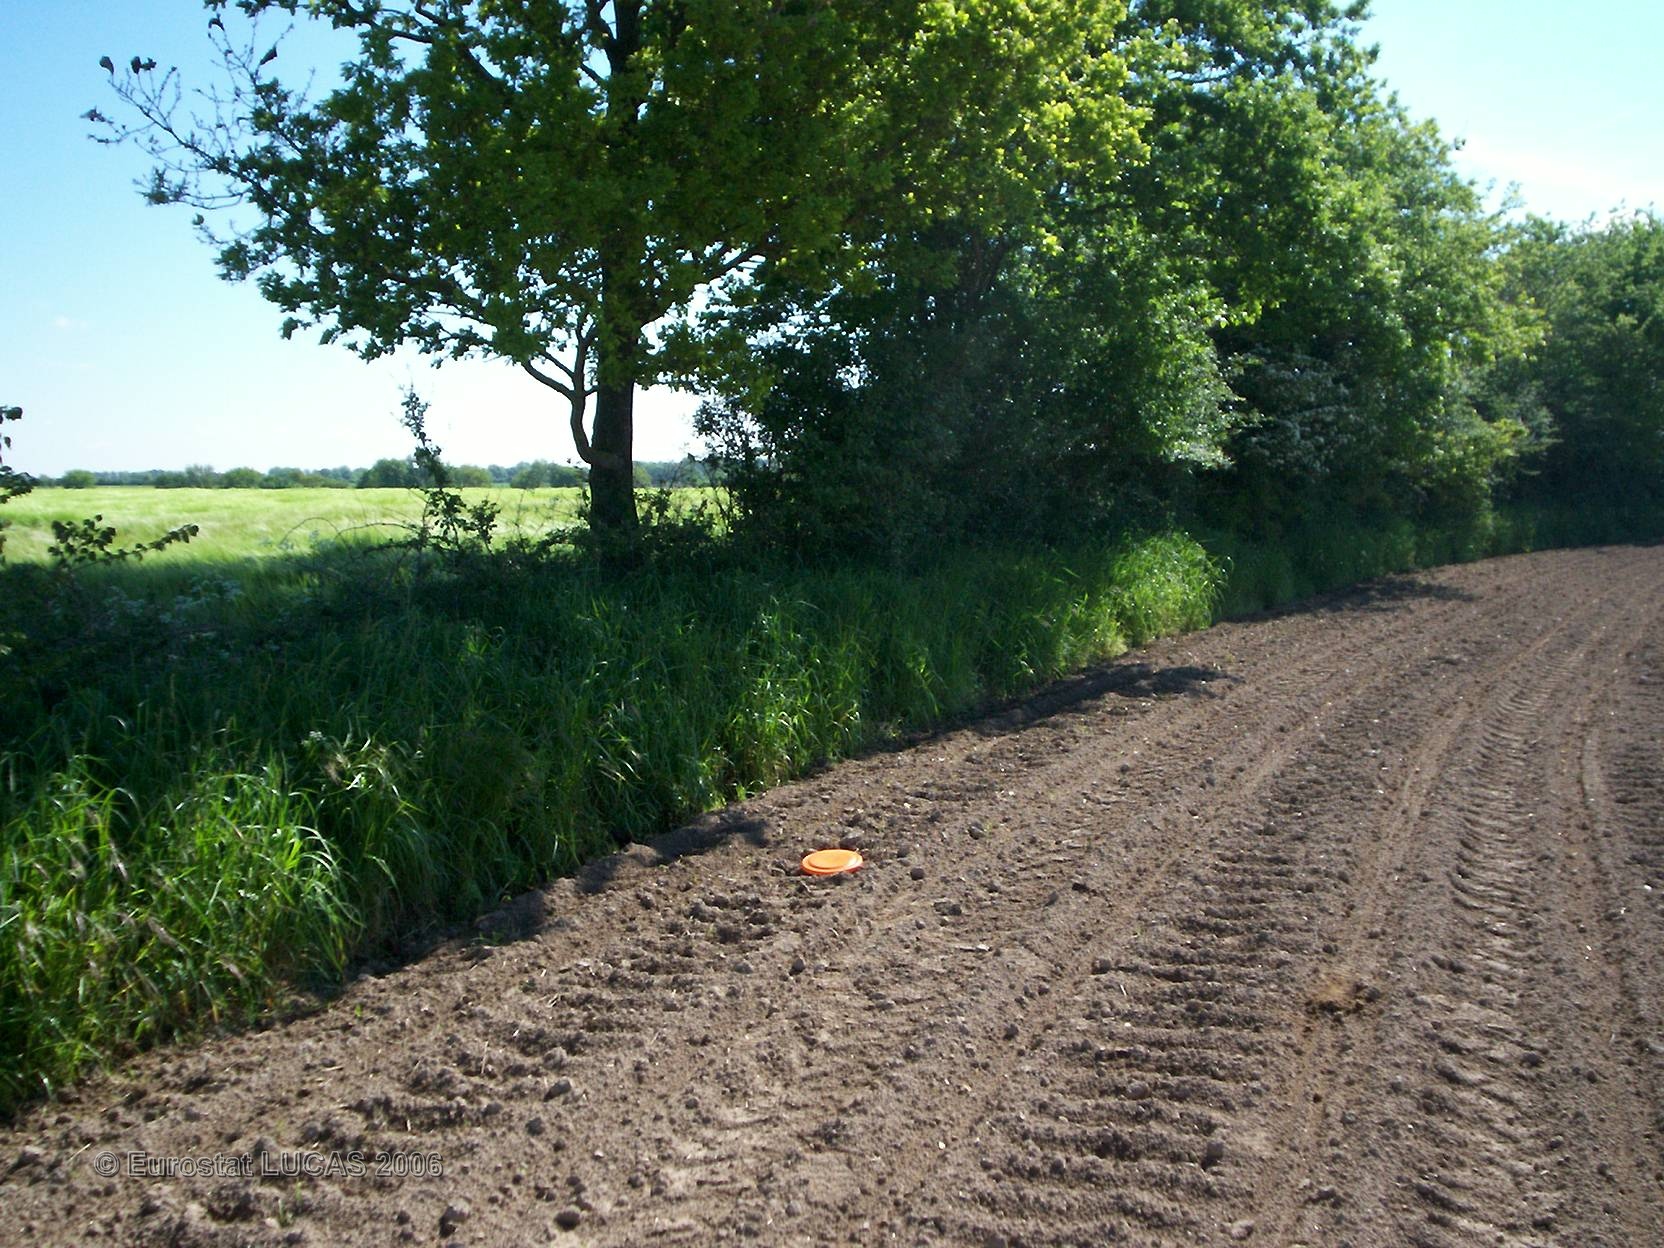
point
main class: Cropland
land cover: Maize
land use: Agriculture (excluding fallow land and kitchen gardens)
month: May
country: FR
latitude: 47.0155
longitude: -1.0190
